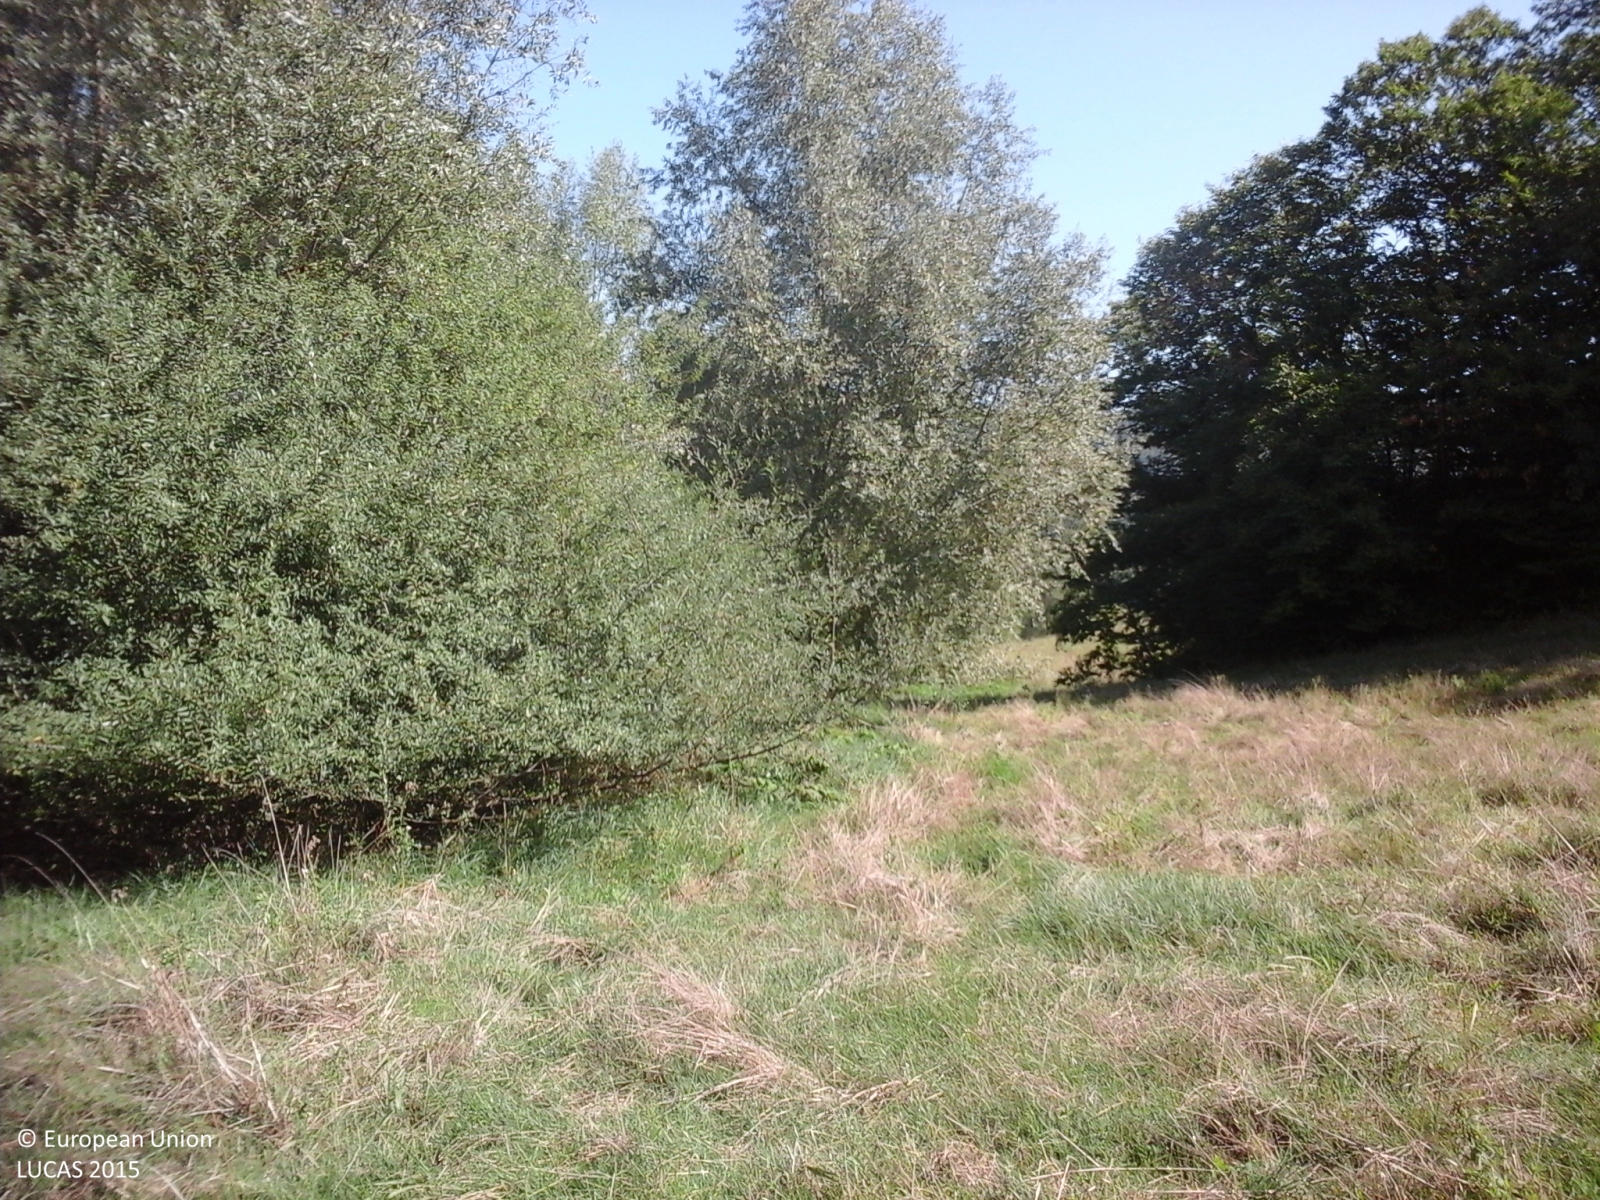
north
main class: Grassland
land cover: Grassland without tree/shrub cover
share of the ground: > 75 %
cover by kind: herbaceous plants 100 %
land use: Agriculture (excluding fallow land and kitchen gardens)
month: August
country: IT
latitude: 42.9597
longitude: 13.3617
